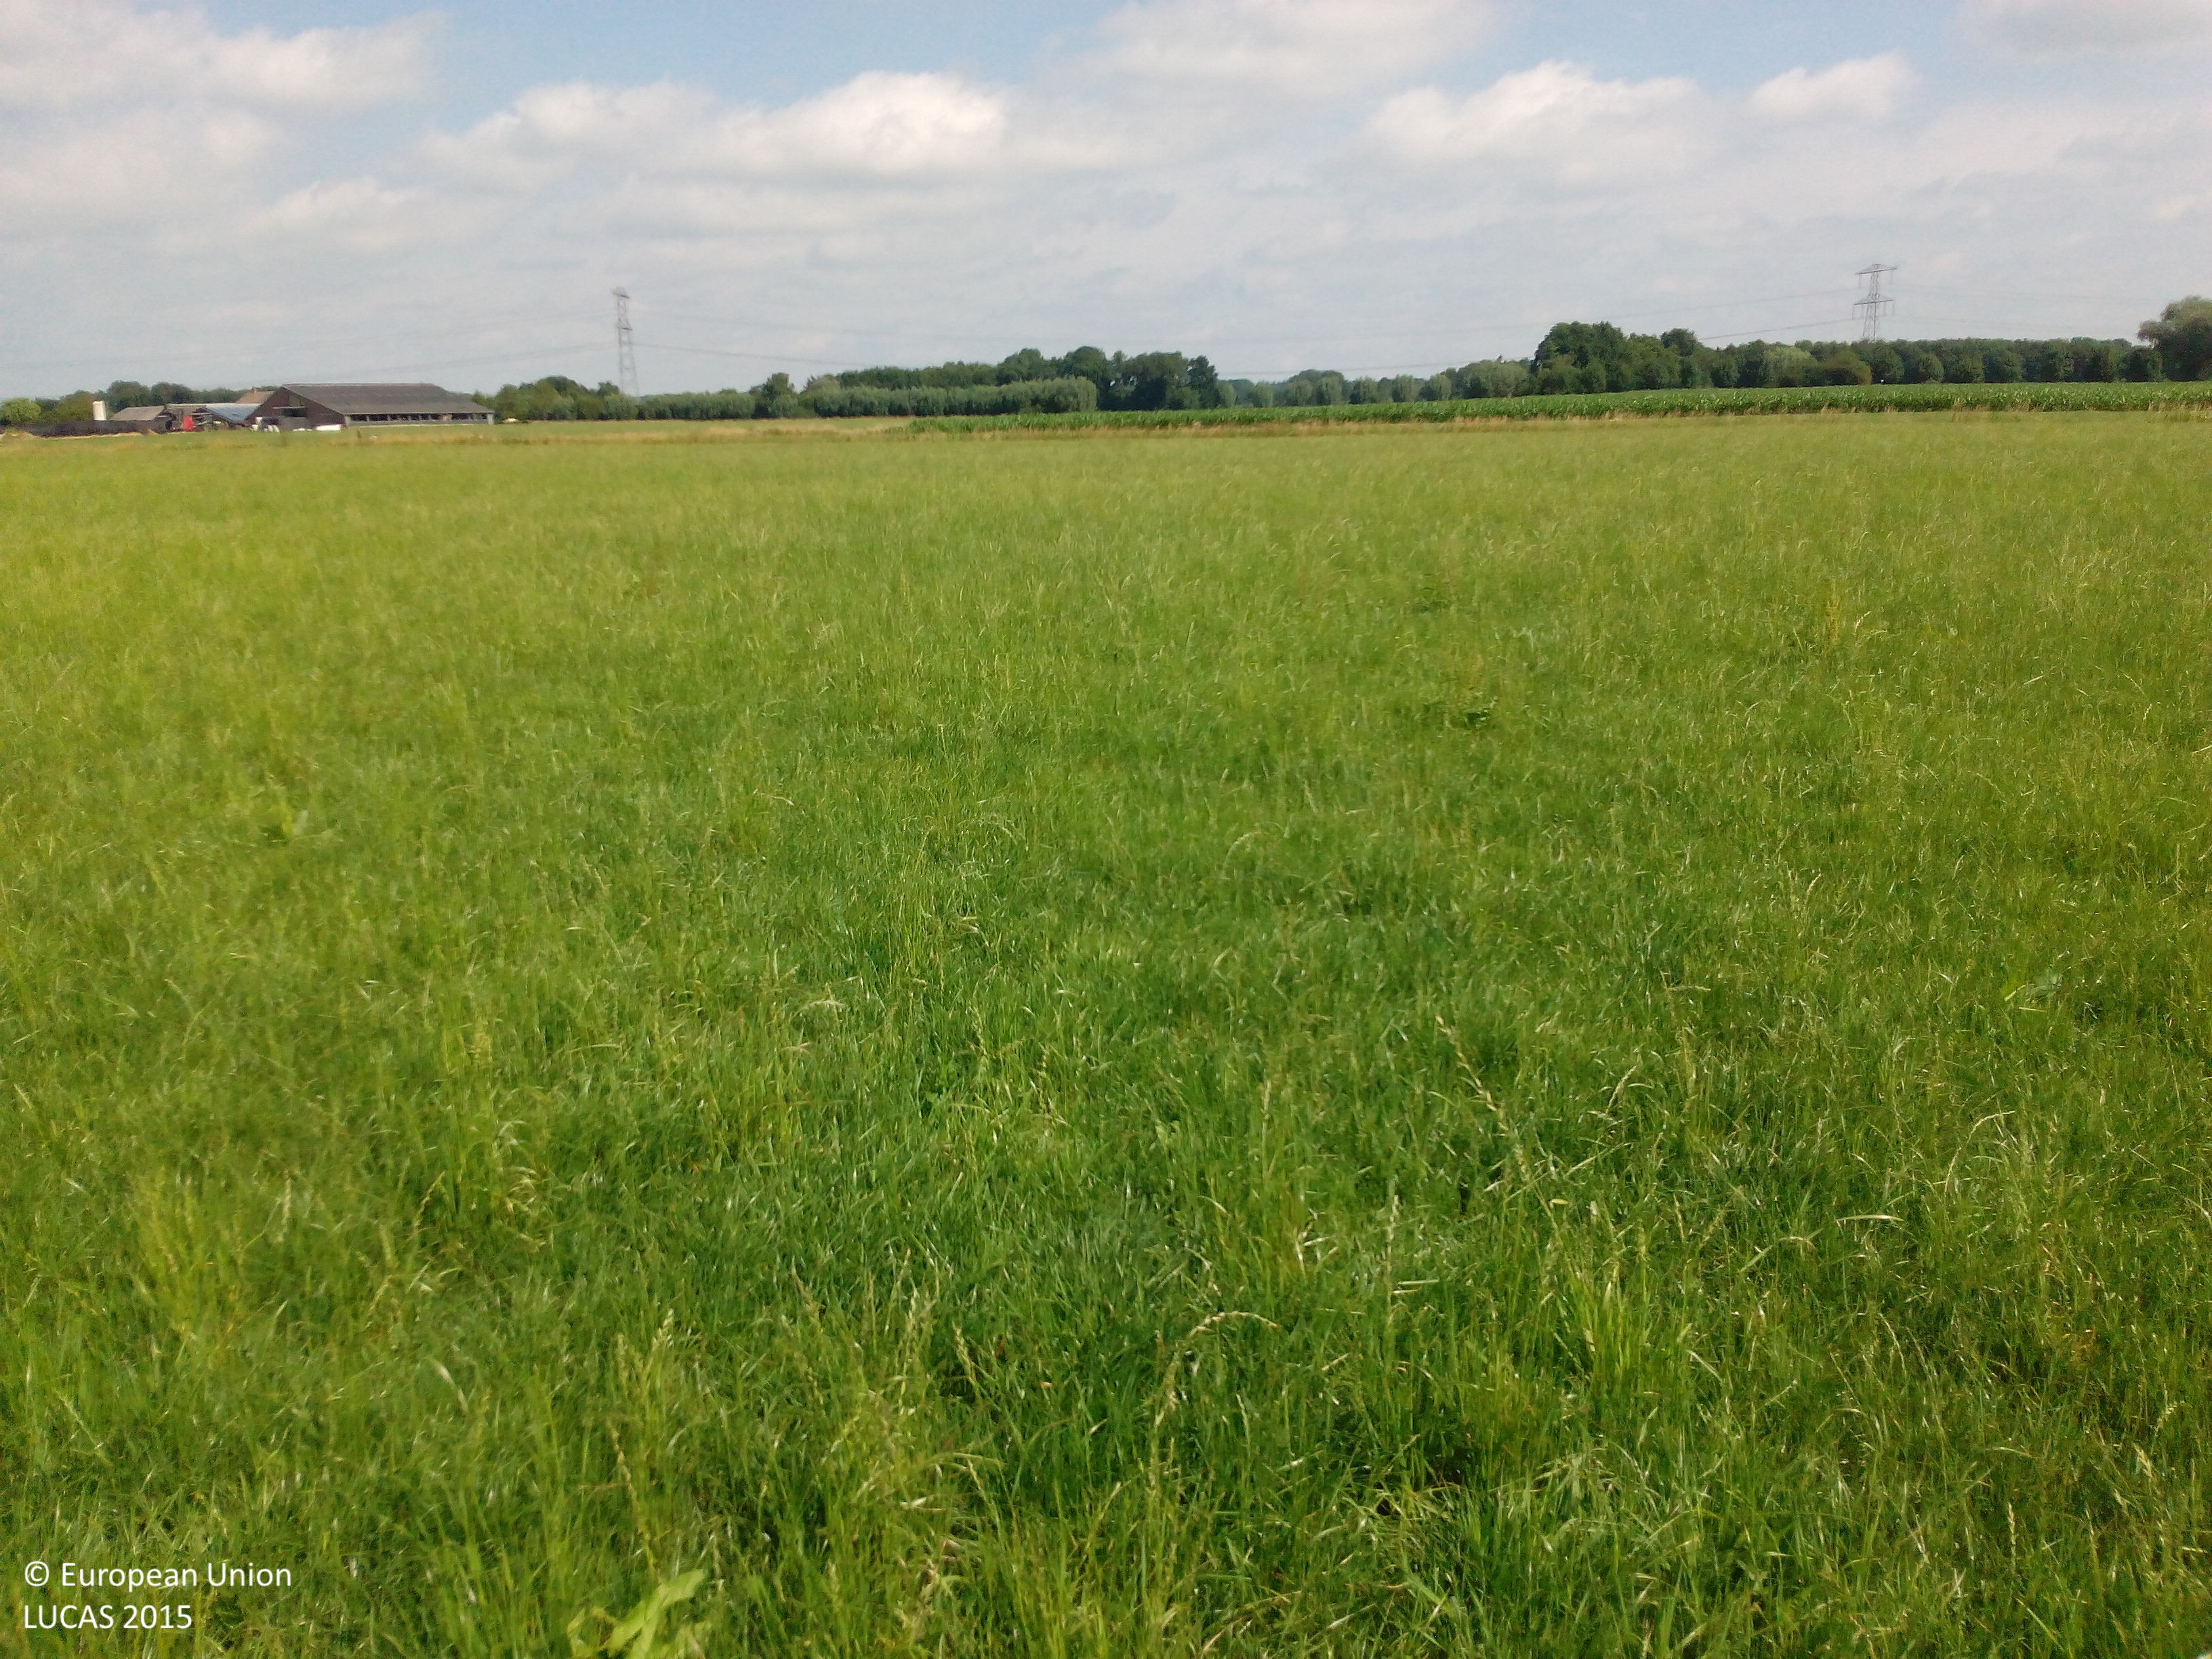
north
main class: Grassland
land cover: Grassland without tree/shrub cover
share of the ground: > 75 %
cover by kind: herbaceous plants 100 %
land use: Agriculture (excluding fallow land and kitchen gardens)
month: July
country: NL
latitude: 51.9757
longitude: 6.2289
